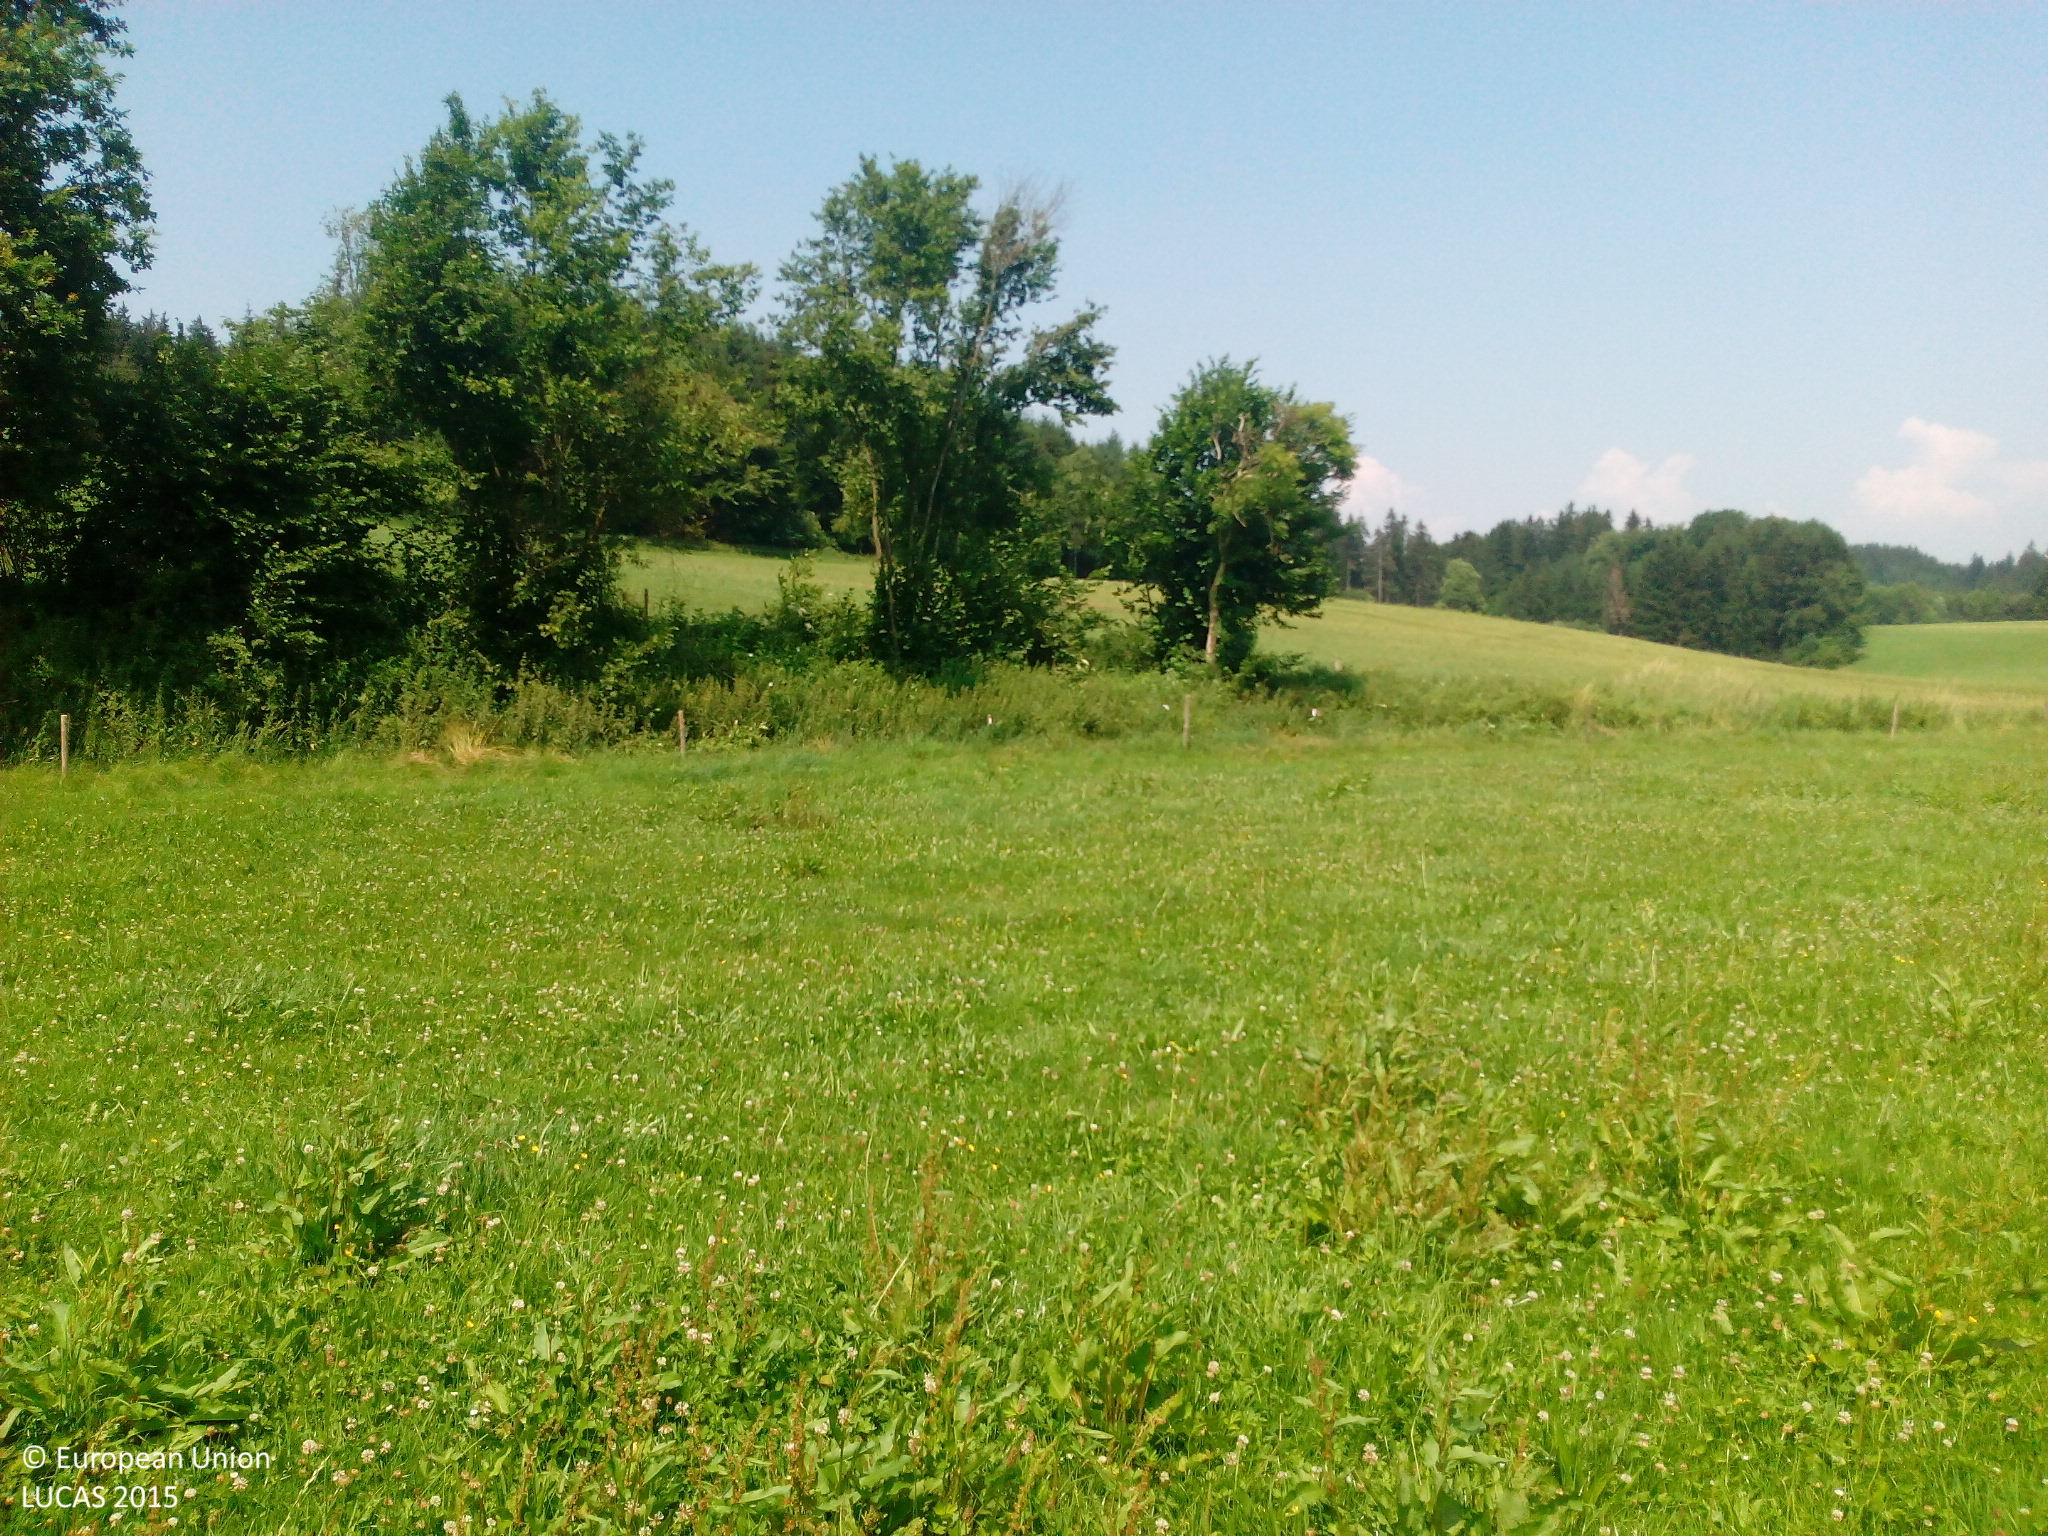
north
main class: Grassland
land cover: Grassland without tree/shrub cover
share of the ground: > 75 %
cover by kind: herbaceous plants 100 %
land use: Agriculture (excluding fallow land and kitchen gardens)
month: July
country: DE
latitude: 47.8615
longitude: 9.3188
